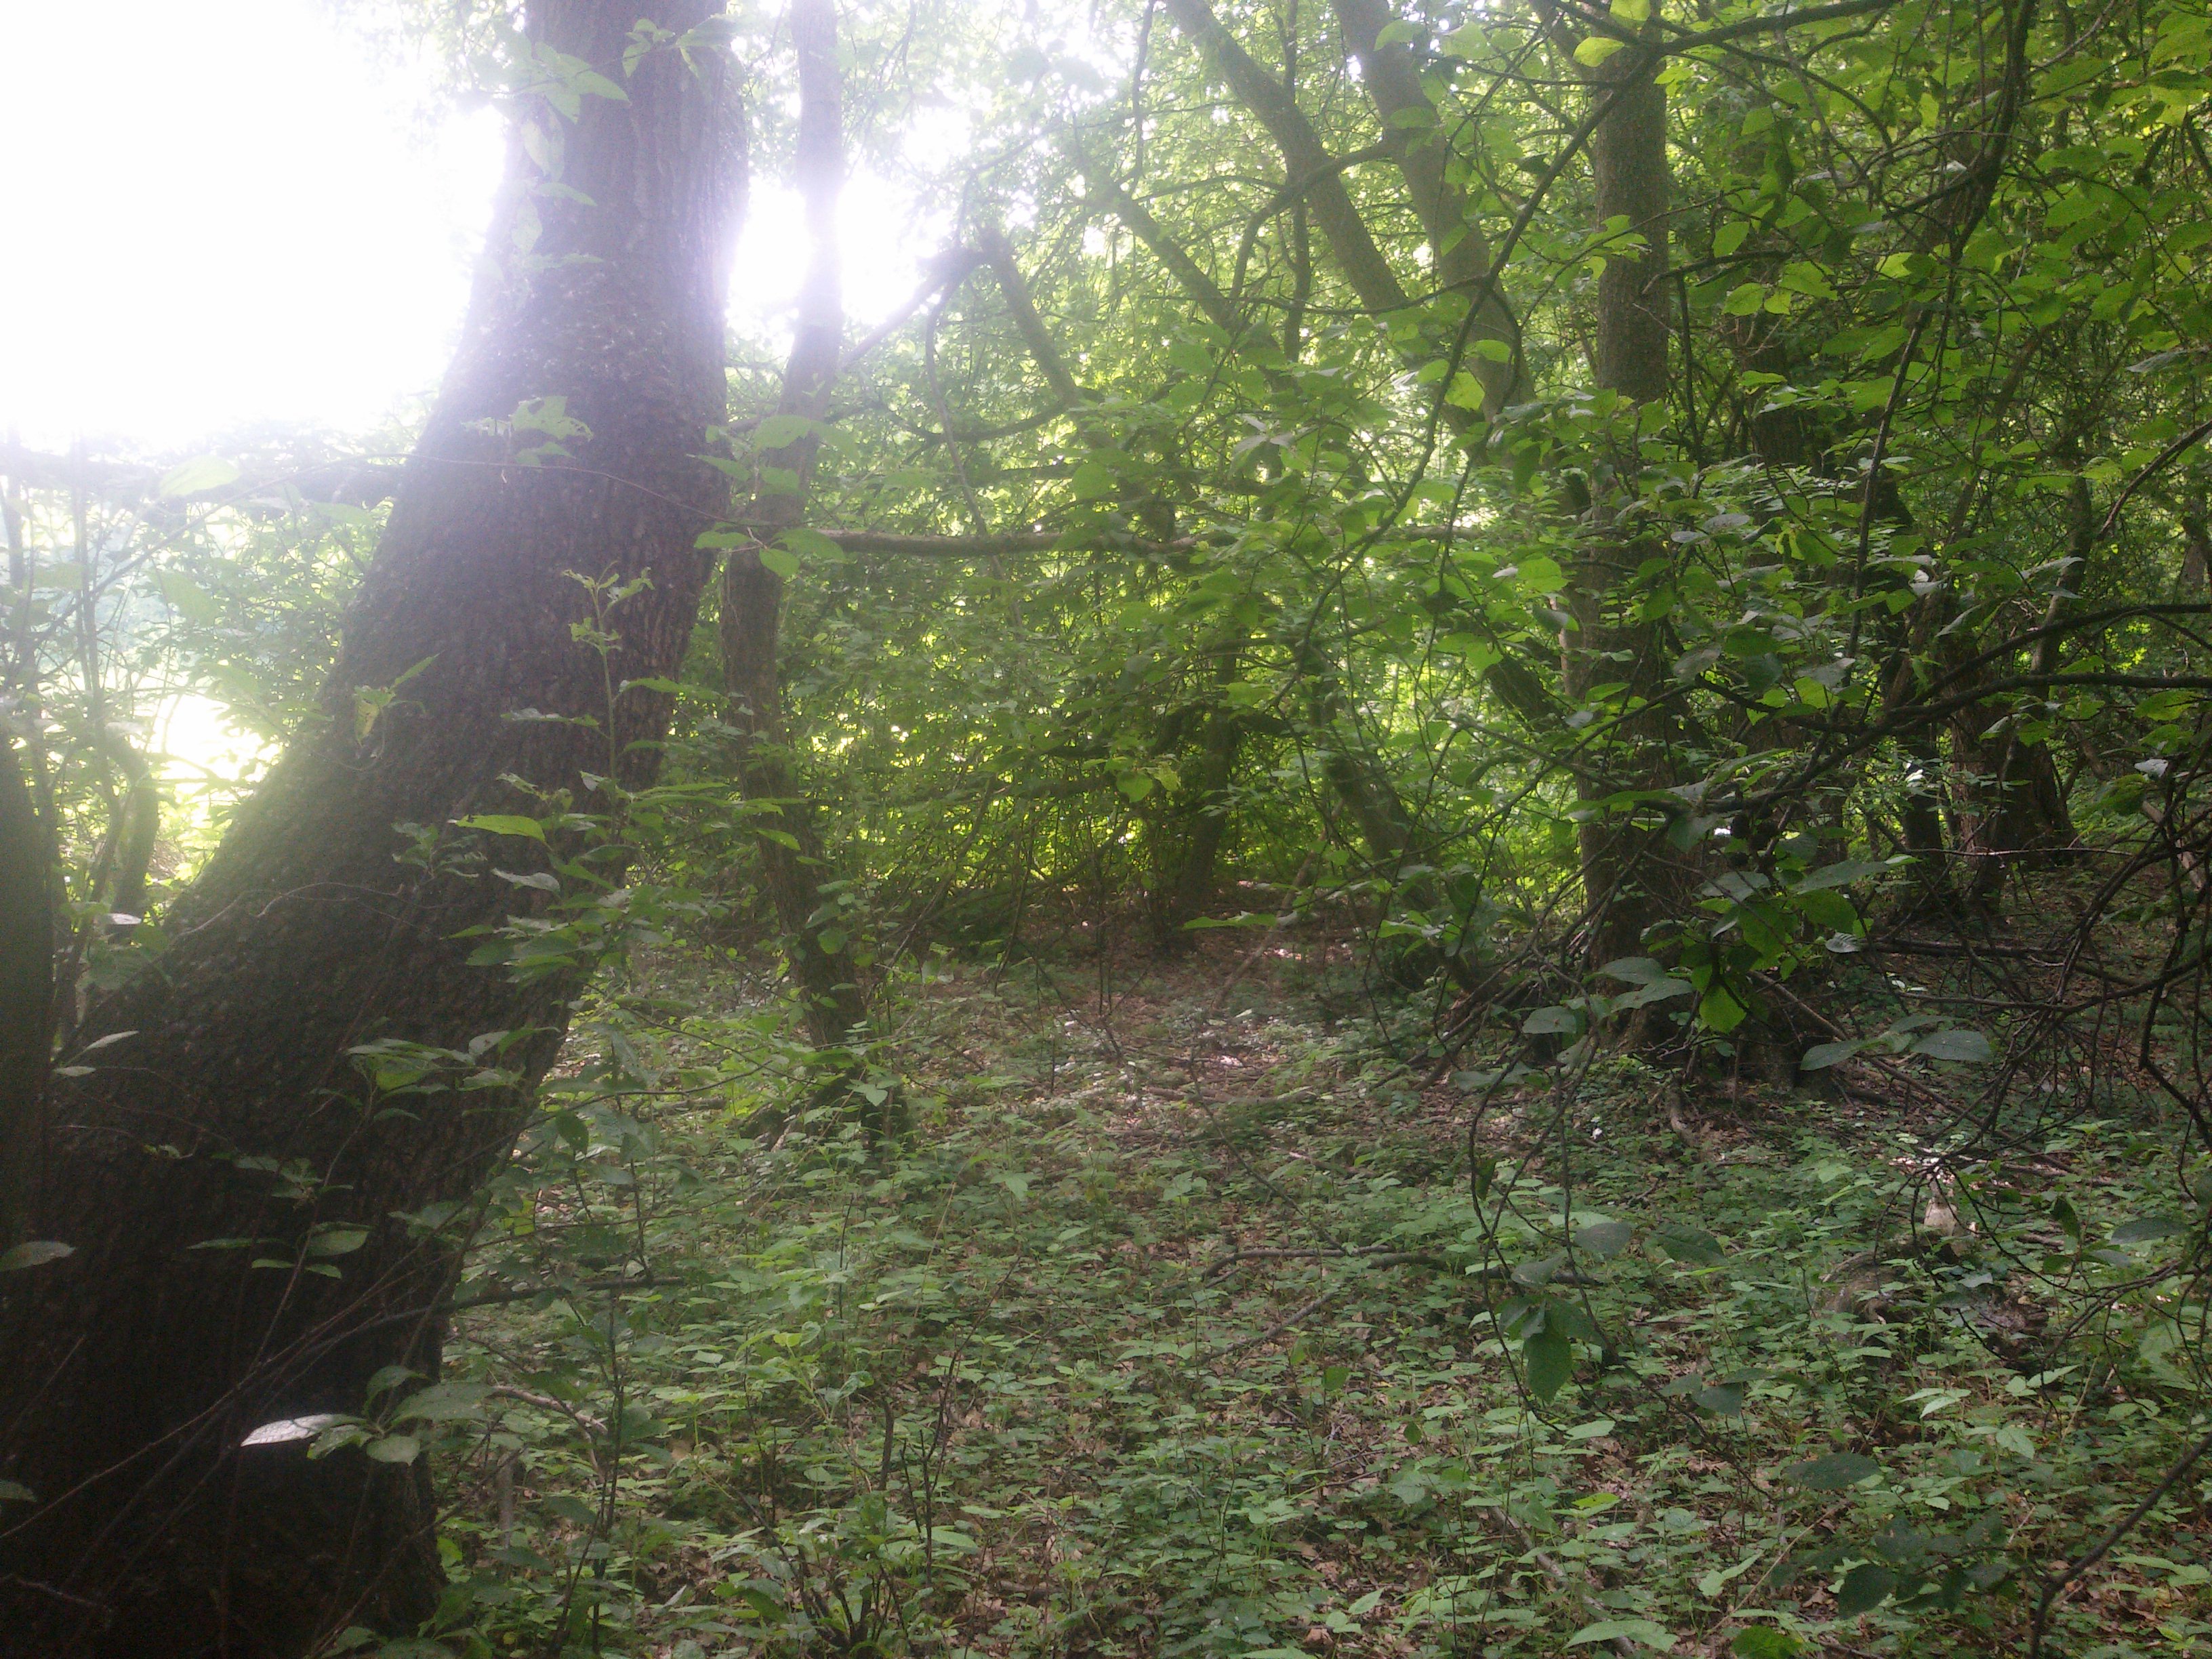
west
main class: Woodland
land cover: Broadleaved woodland
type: mesophytic deciduous forest
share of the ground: > 75 %
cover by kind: broadleaved forest trees 80 %, herbaceous plants 10 %, shrubs 5 %
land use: Forestry
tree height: > 5 m
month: May
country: PL
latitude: 50.3091
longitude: 17.6097
